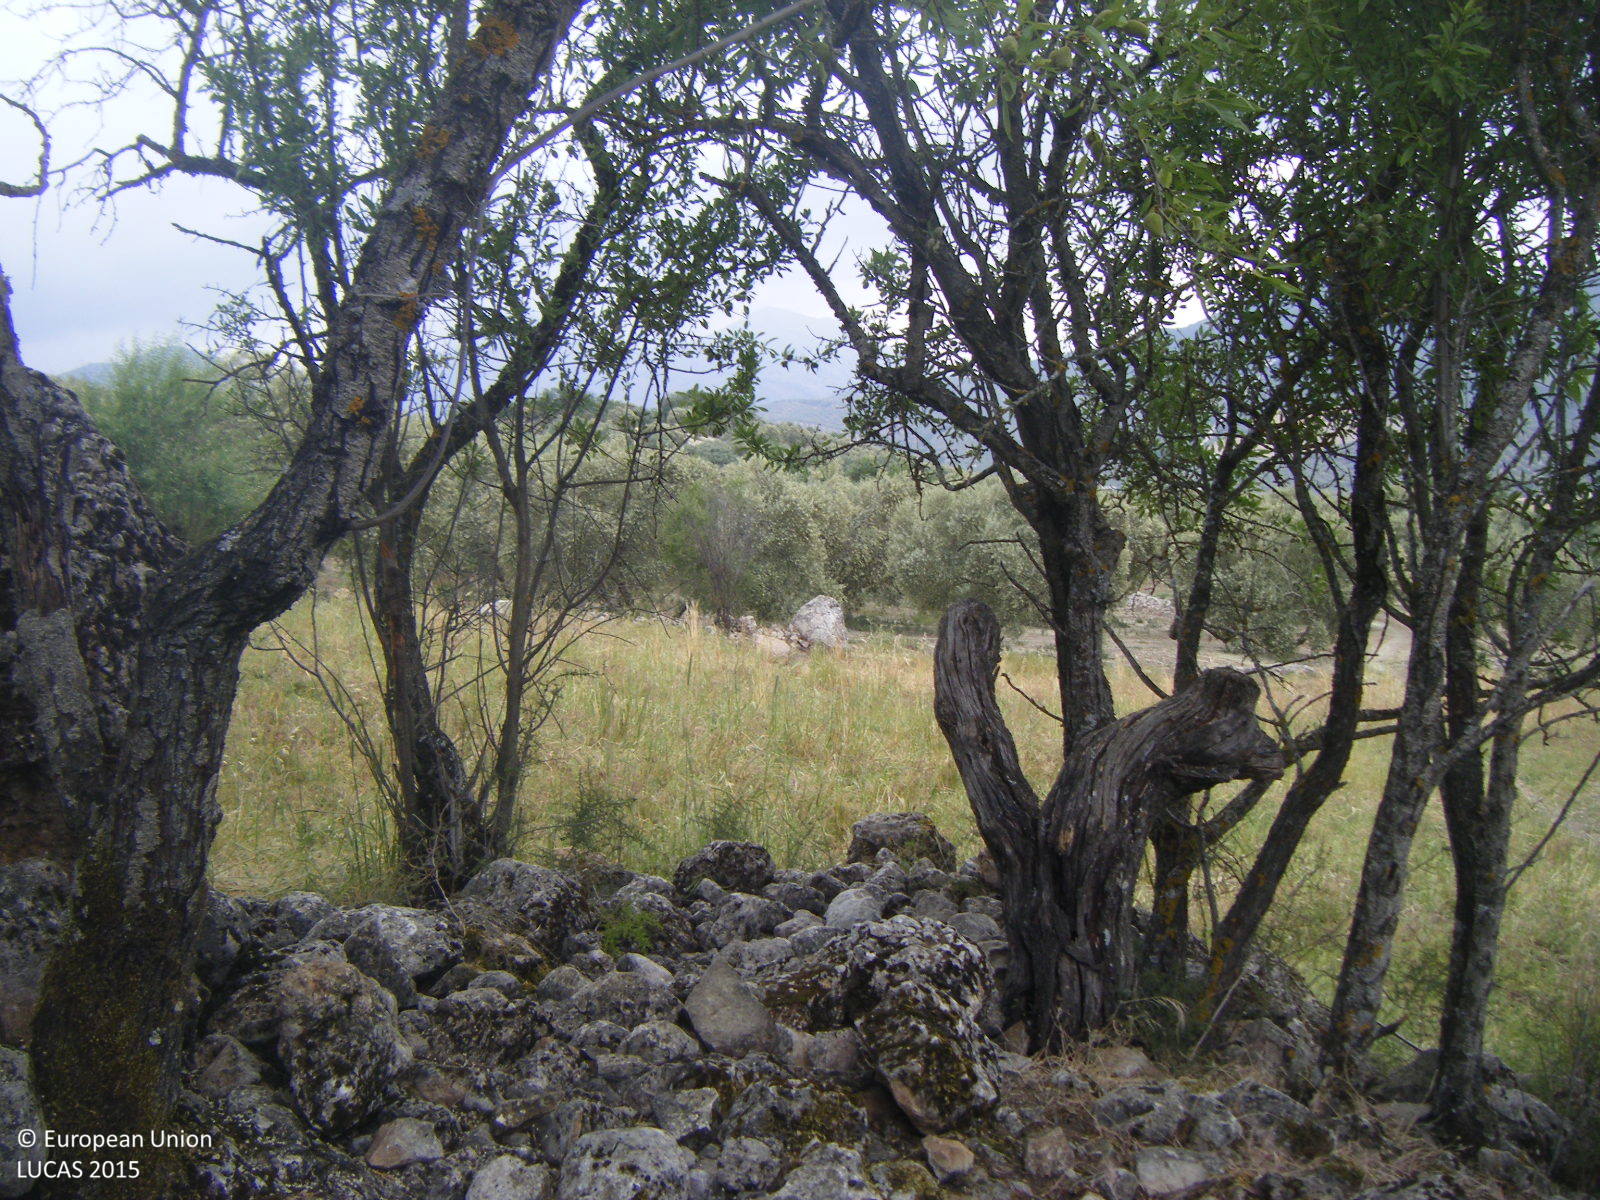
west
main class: Shrubland
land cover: Shrubland with sparse tree cover
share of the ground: 25 - 50 %
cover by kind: consolidated bare surface 35 %, shrubs 30 %, herbaceous plants 30 %, broadleaved forest trees 5 %
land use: Semi-natural and natural areas not in use
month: May
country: ES
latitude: 36.9787
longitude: -4.3846
